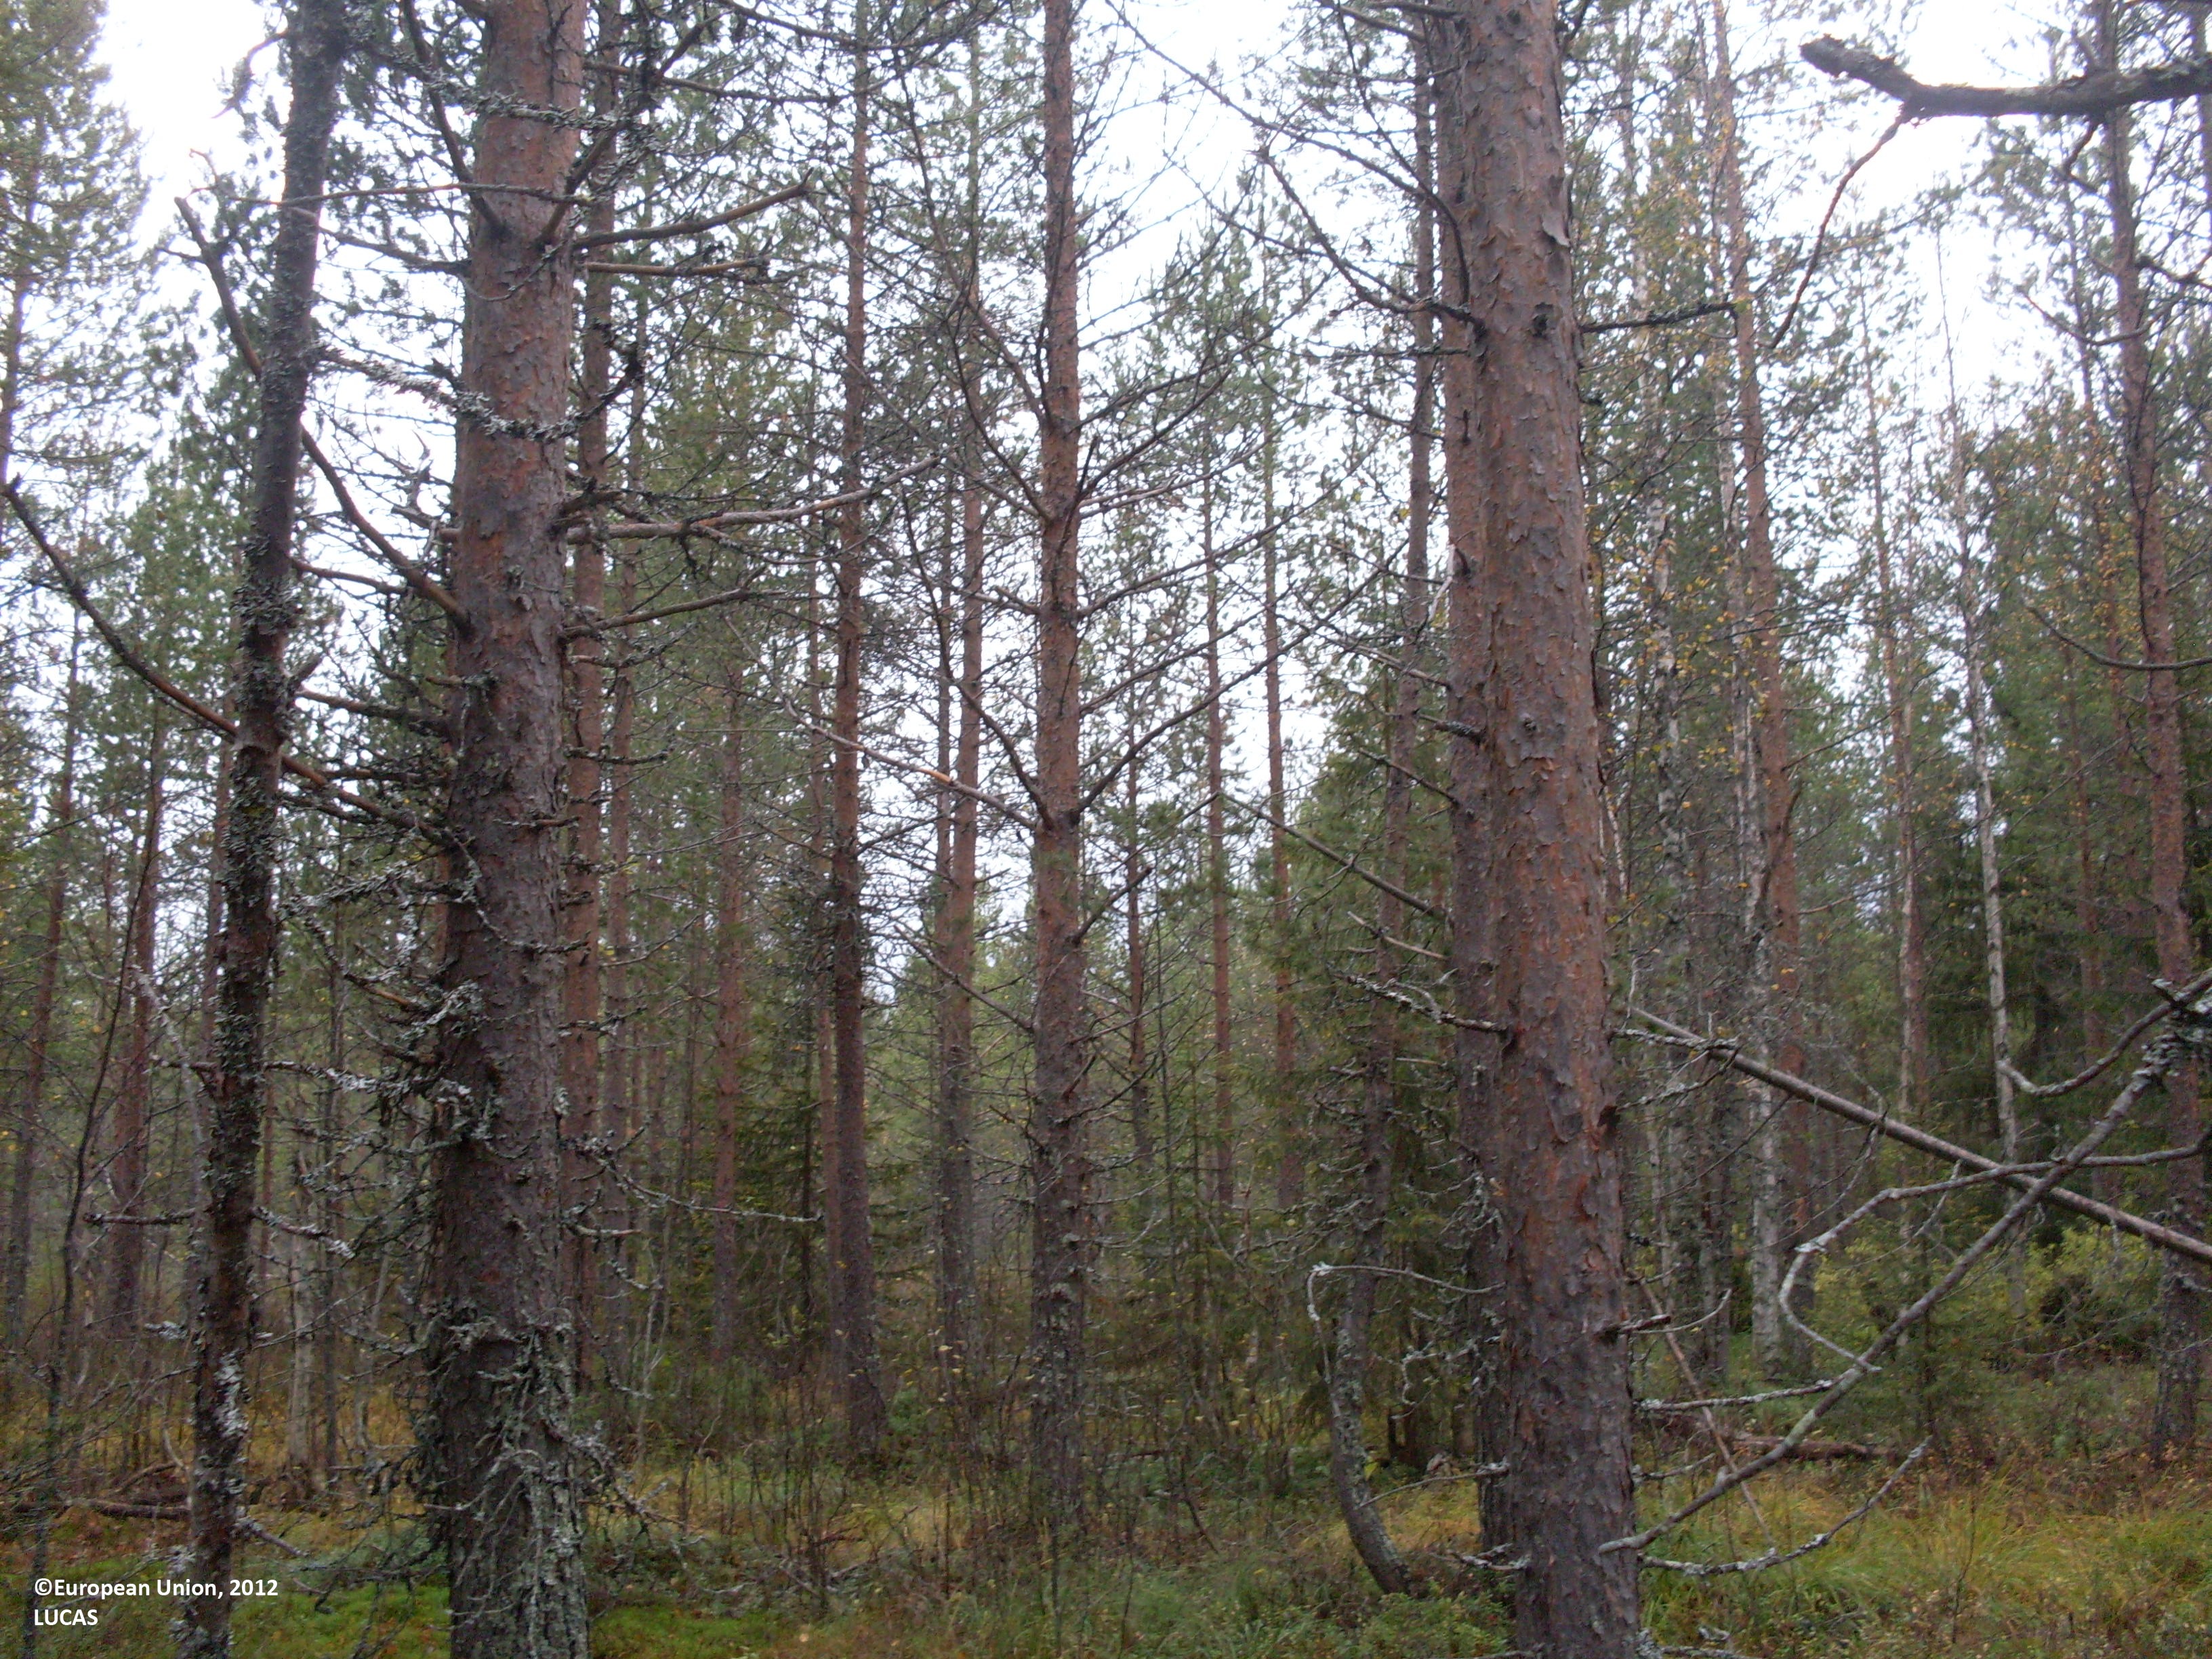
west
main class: Woodland
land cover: Pine dominated mixed woodland
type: boreal forest
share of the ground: 50 - 75 %
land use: Forestry
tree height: > 5 m
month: September
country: FI
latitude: 64.8784
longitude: 28.6916
